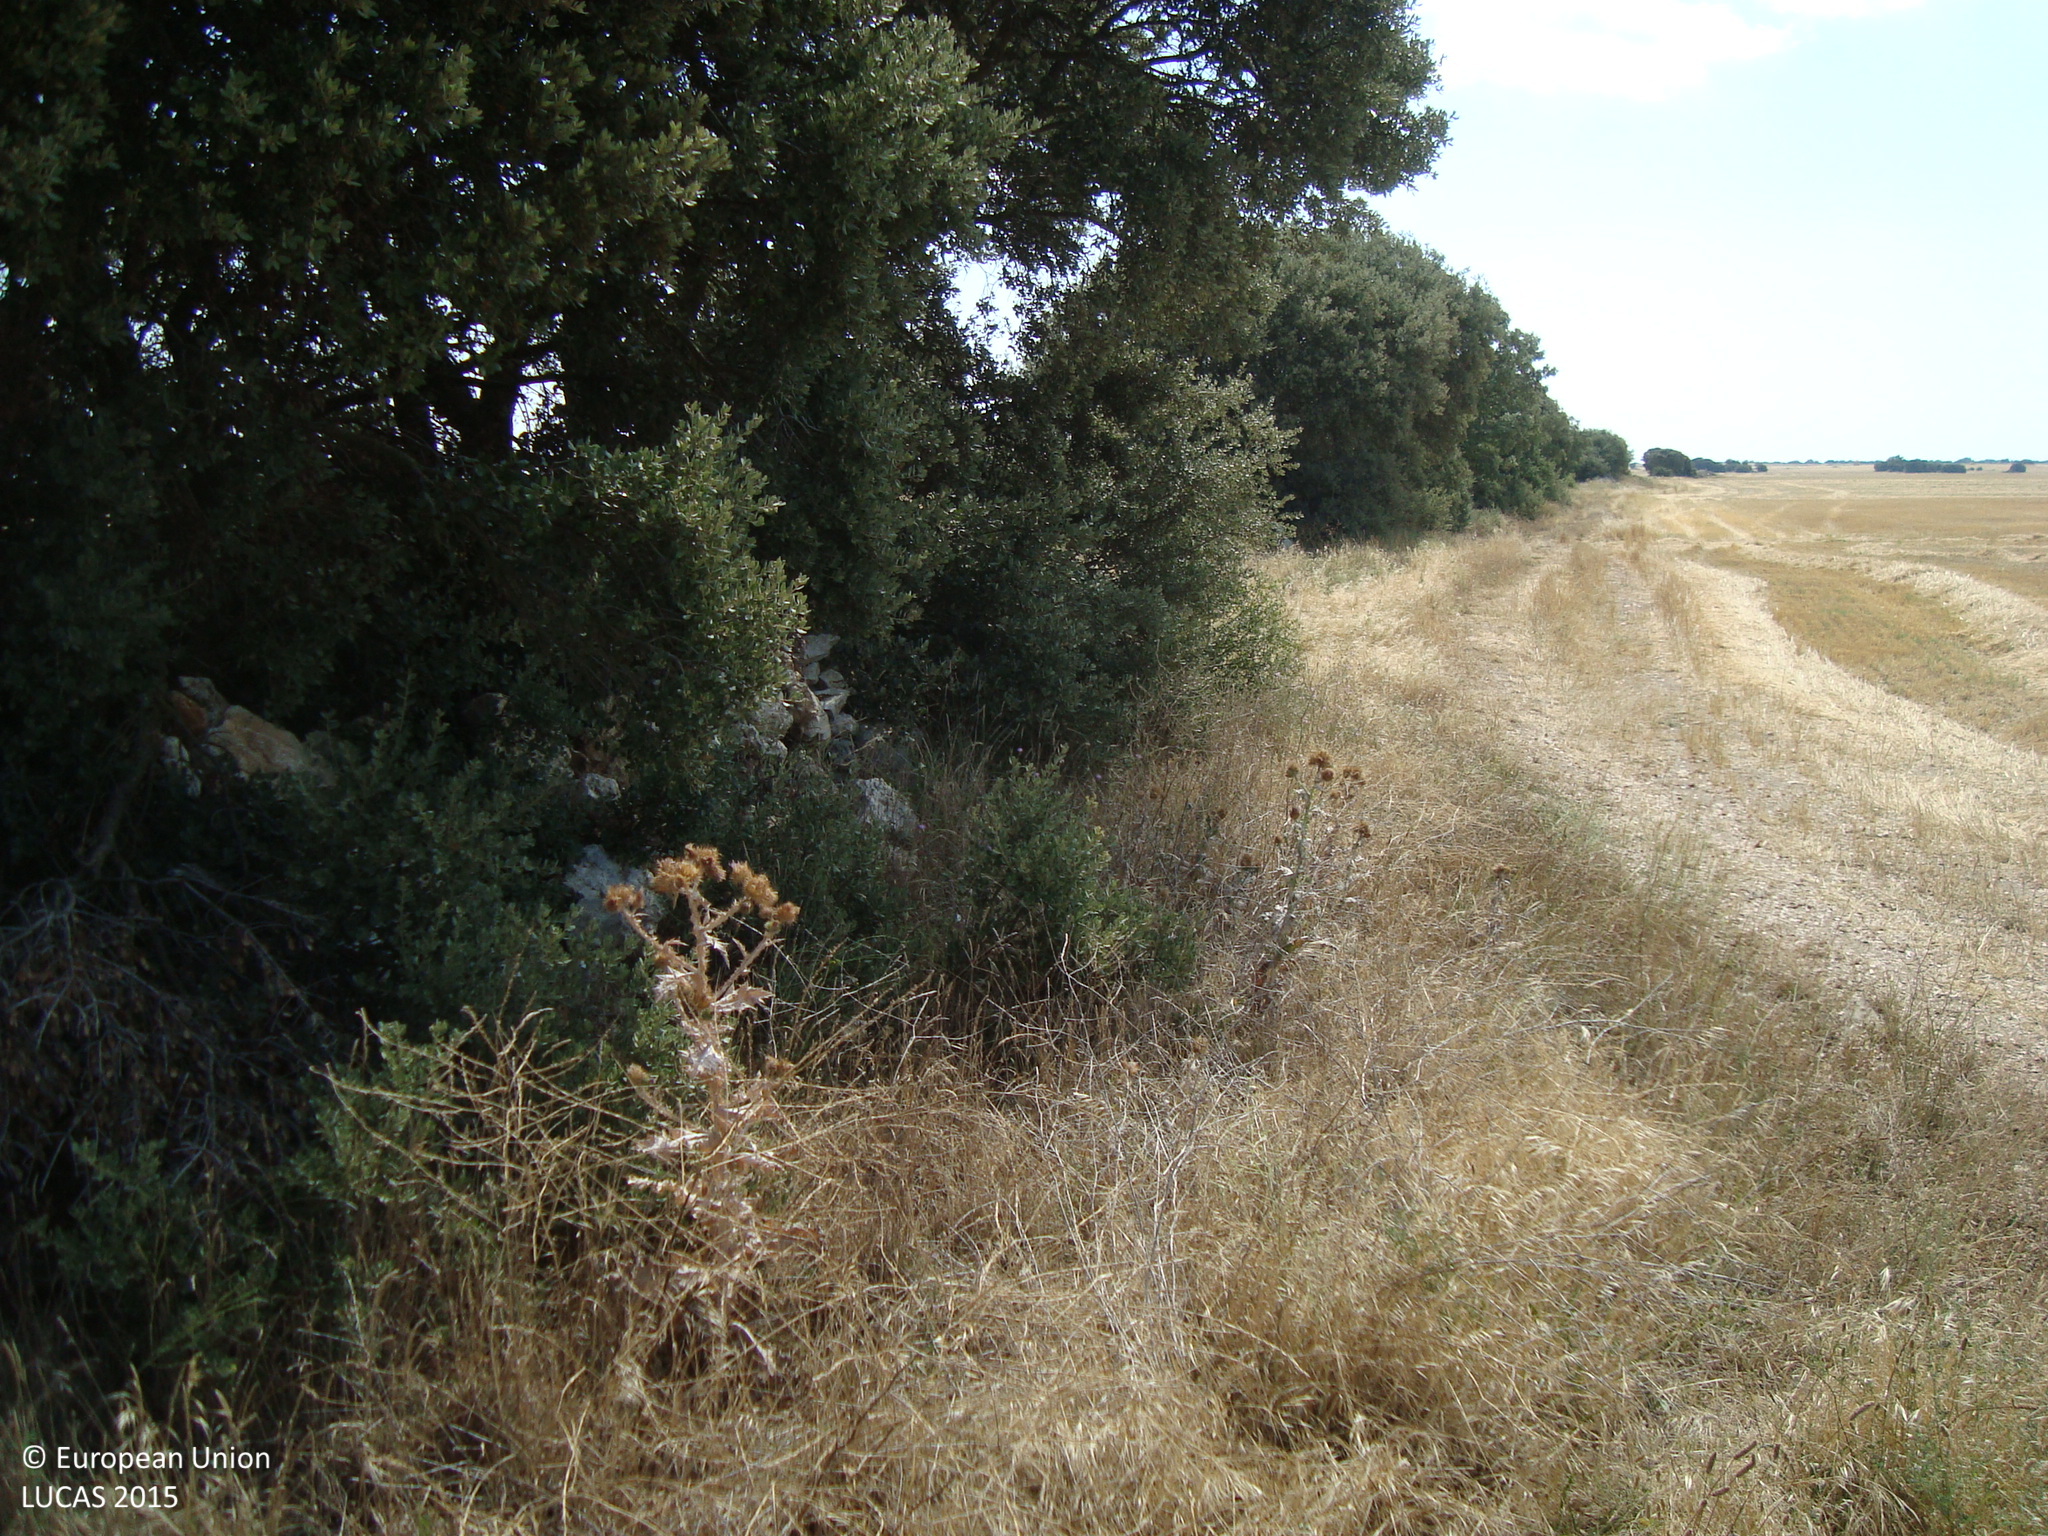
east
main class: Grassland
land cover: Grassland with sparse tree/shrub cover
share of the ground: > 75 %
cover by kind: herbaceous plants 75 %, broadleaved forest trees 5 %, shrubs 5 %
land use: Agriculture (excluding fallow land and kitchen gardens)
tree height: > 5 m
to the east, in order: Grassland with sparse tree/shrub cover; Lines of trees; Grassland with sparse tree/shrub cover; Barley
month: July
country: ES
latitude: 41.9002
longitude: -4.2272
